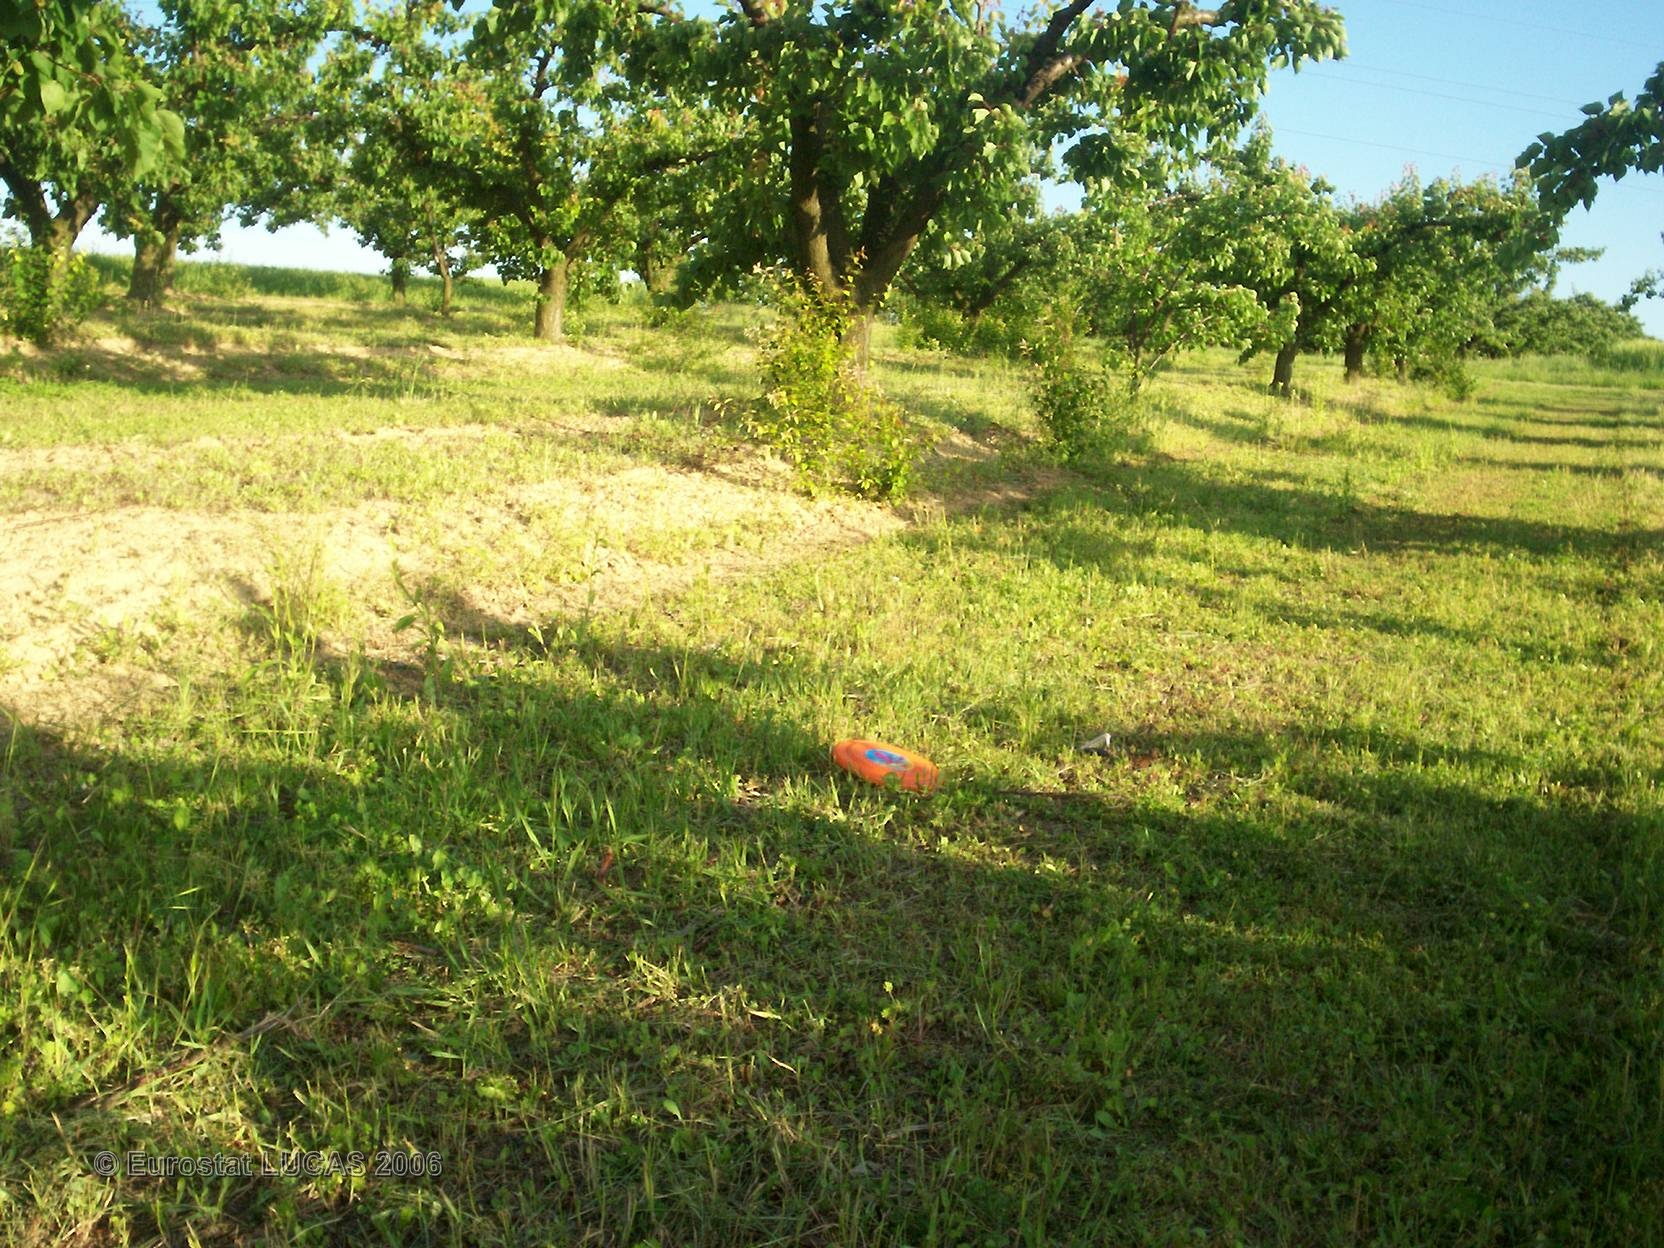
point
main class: Cropland
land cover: Other fruit trees and berries
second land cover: Grassland with sparse tree/shrub cover
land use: Agriculture (excluding fallow land and kitchen gardens)
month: May
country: FR
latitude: 45.3022
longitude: 4.7631
